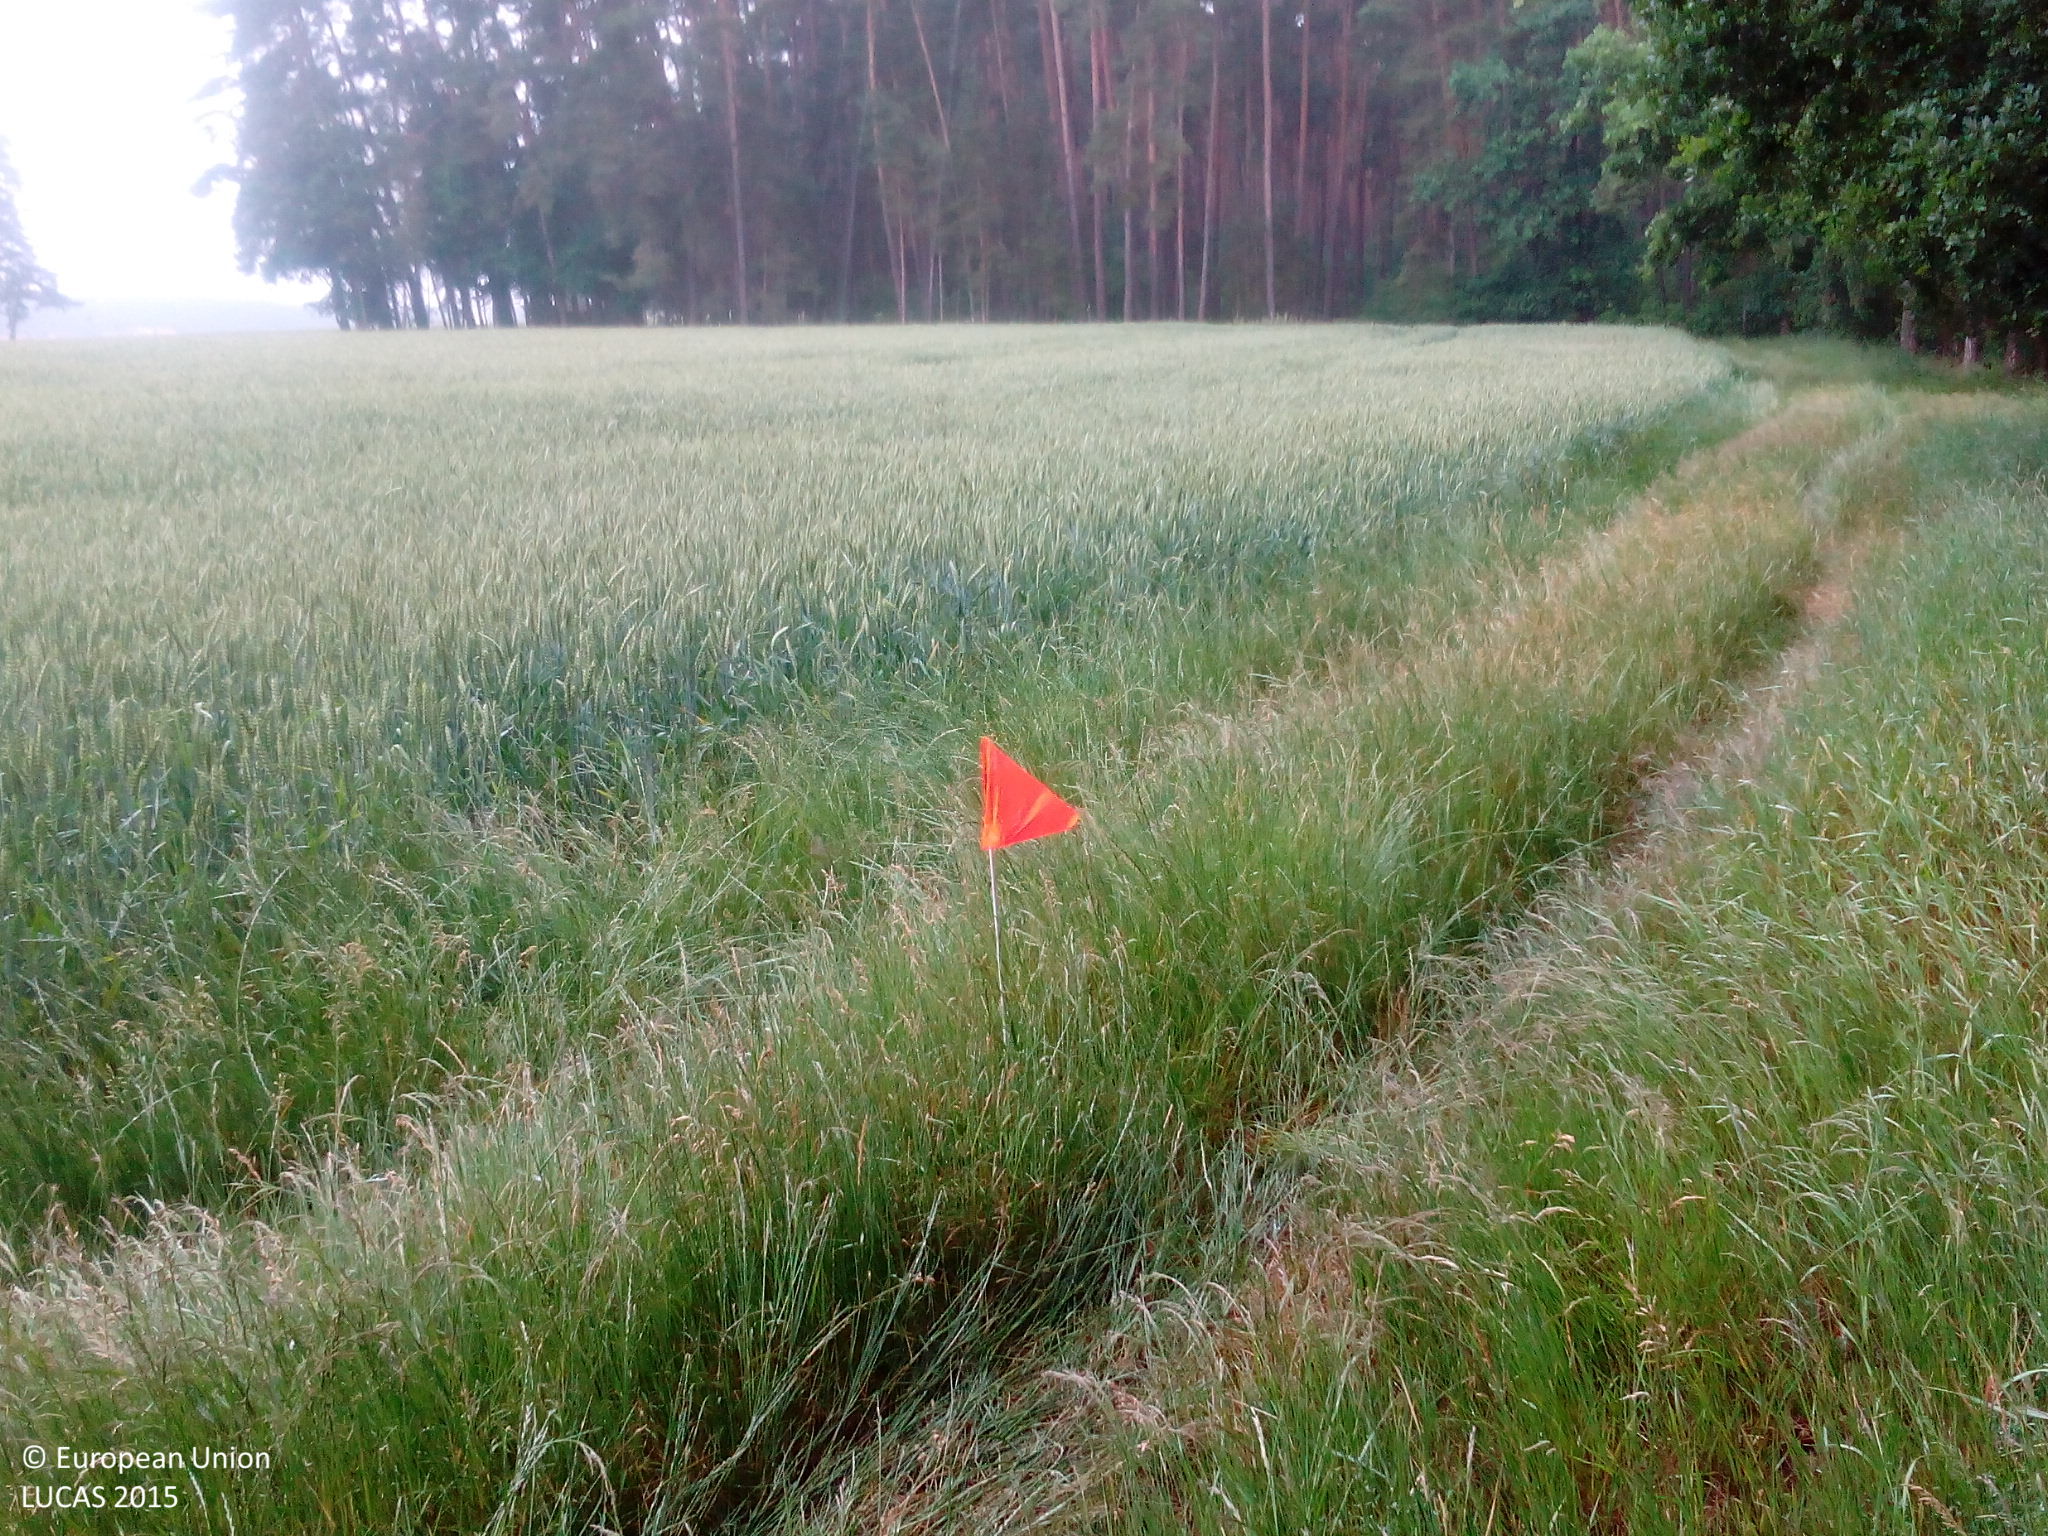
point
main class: Woodland
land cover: Pine dominated coniferous woodland
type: hemiboreal forest and nemoral coniferous forest and mixed broadleaved-coniferous forest
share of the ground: > 75 %
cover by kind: coniferous forest trees 75 %, herbaceous plants 20 %, broadleaved forest trees 5 %
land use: Forestry
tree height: > 5 m
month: June
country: DE
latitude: 49.2814
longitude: 10.8932
